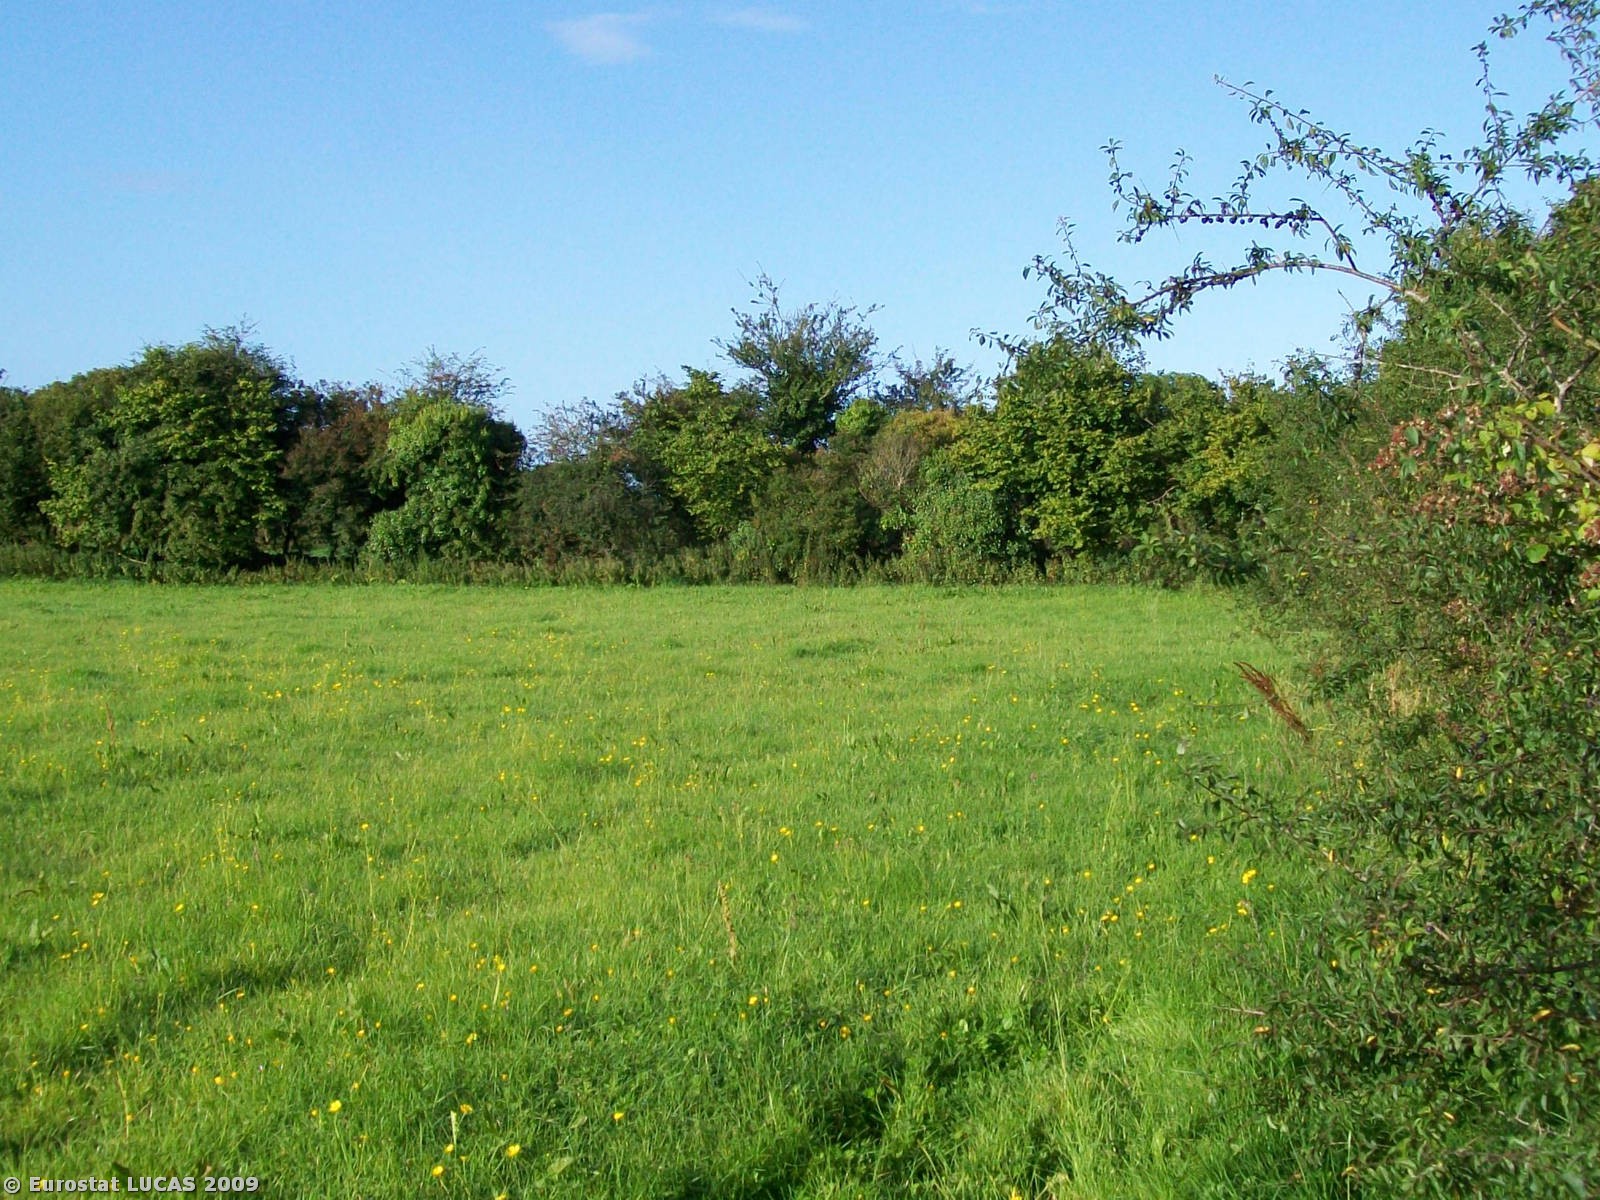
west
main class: Grassland
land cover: Grassland without tree/shrub cover
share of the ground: > 75 %
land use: Agriculture (excluding fallow land and kitchen gardens)
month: August
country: IE
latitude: 53.2283
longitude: -8.7635
